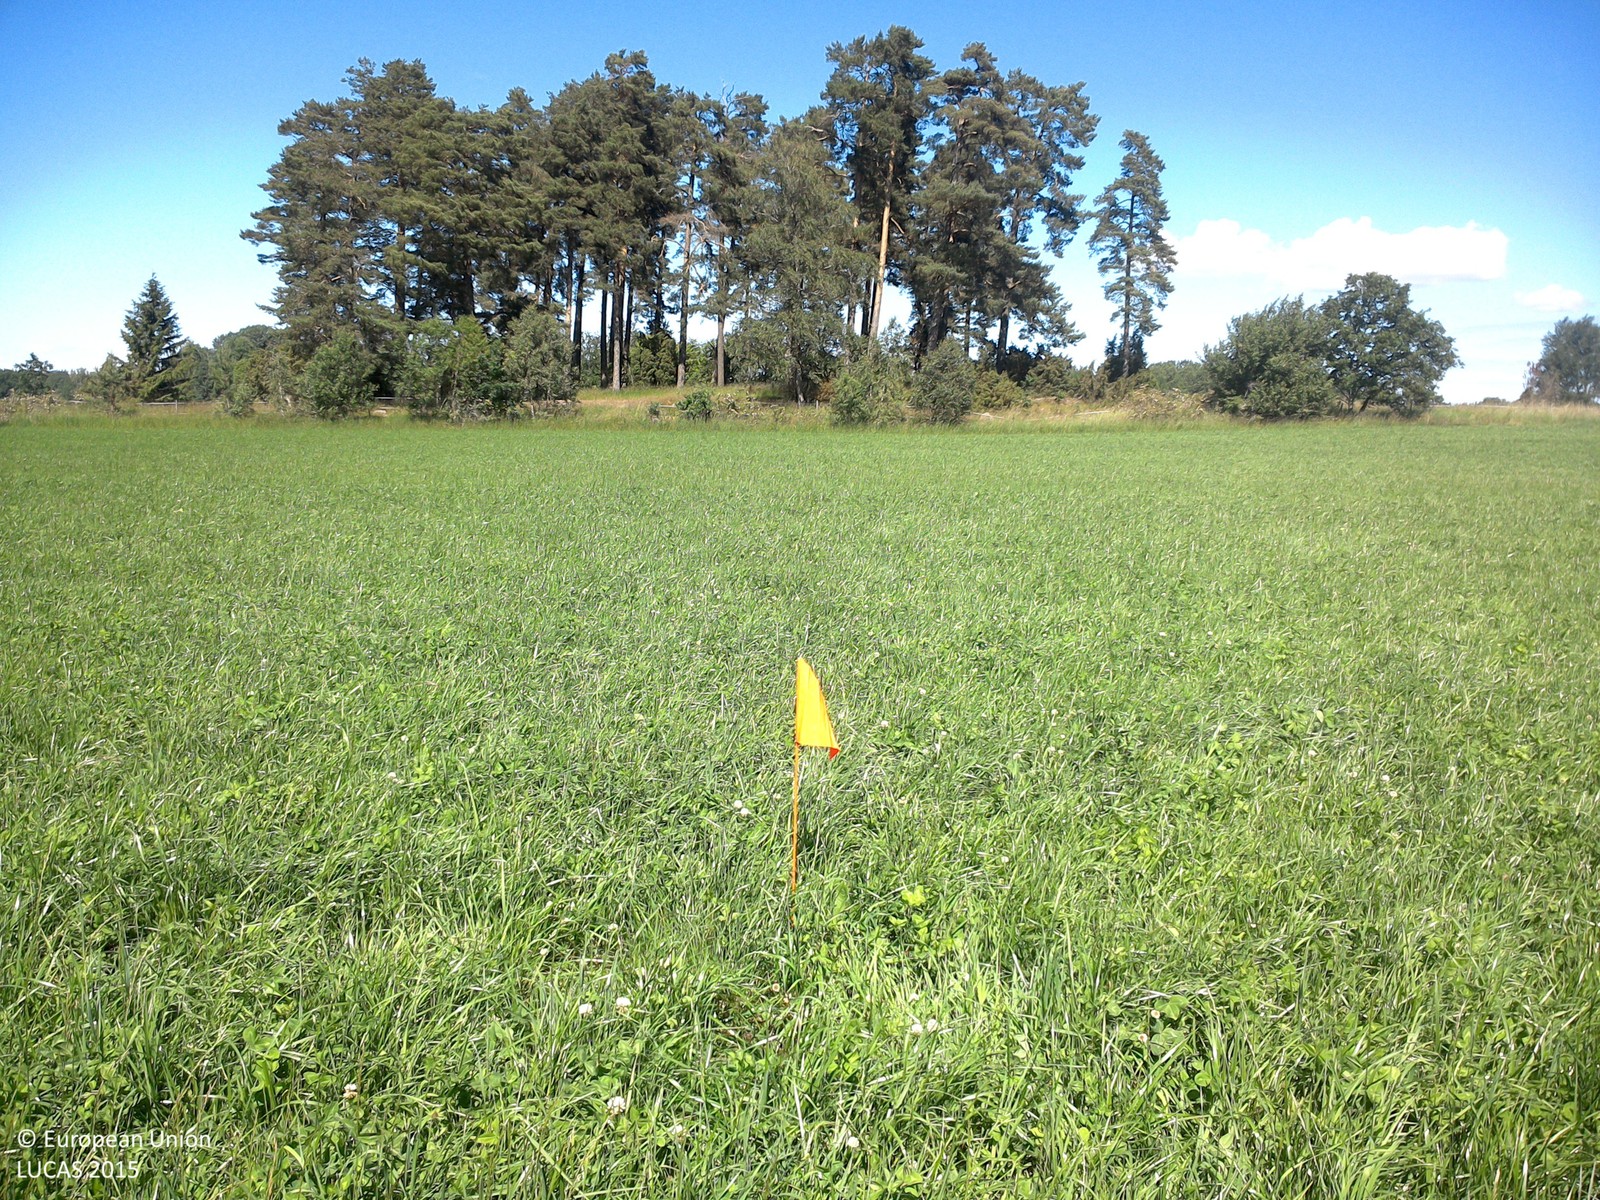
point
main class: Cropland
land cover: Other leguminous and mixtures for fodder
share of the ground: > 75 %
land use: Agriculture (excluding fallow land and kitchen gardens)
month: July
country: SE
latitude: 58.3258
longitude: 15.4414
